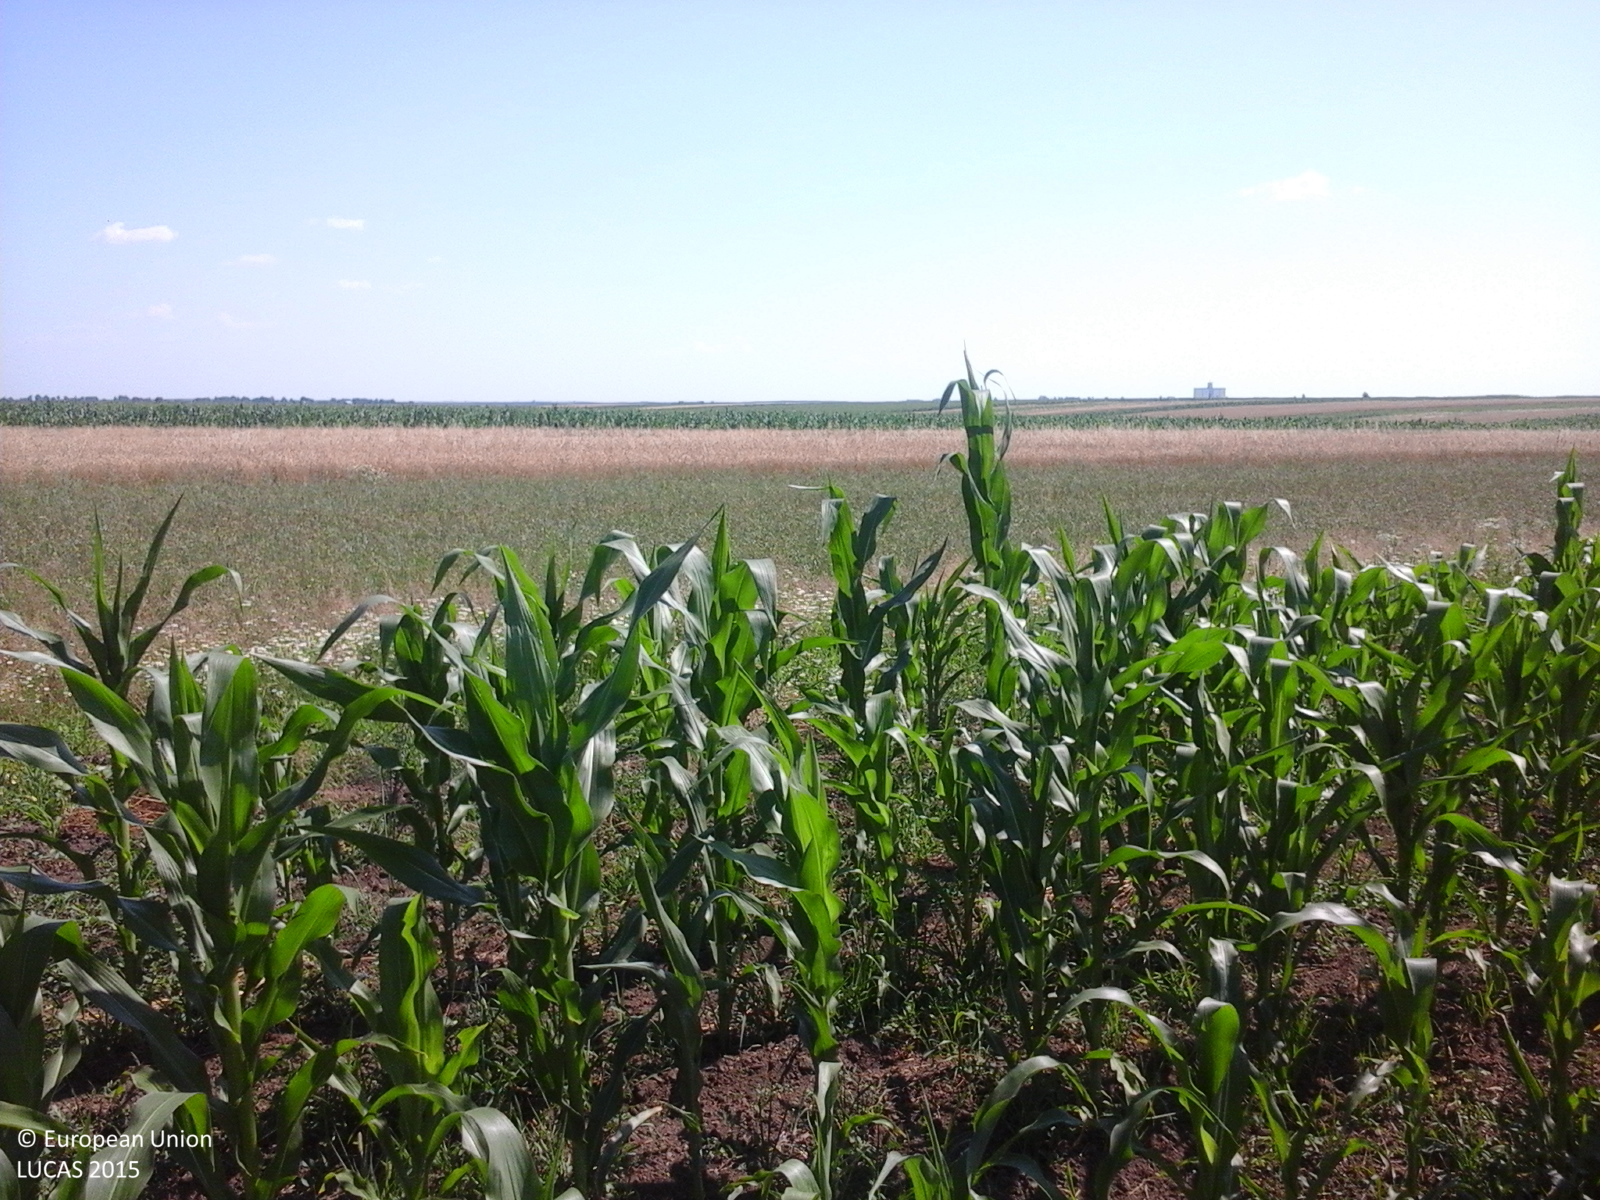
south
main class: Cropland
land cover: Maize
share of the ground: 50 - 75 %
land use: Agriculture (excluding fallow land and kitchen gardens)
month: July
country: RO
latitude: 44.5153
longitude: 24.6291
